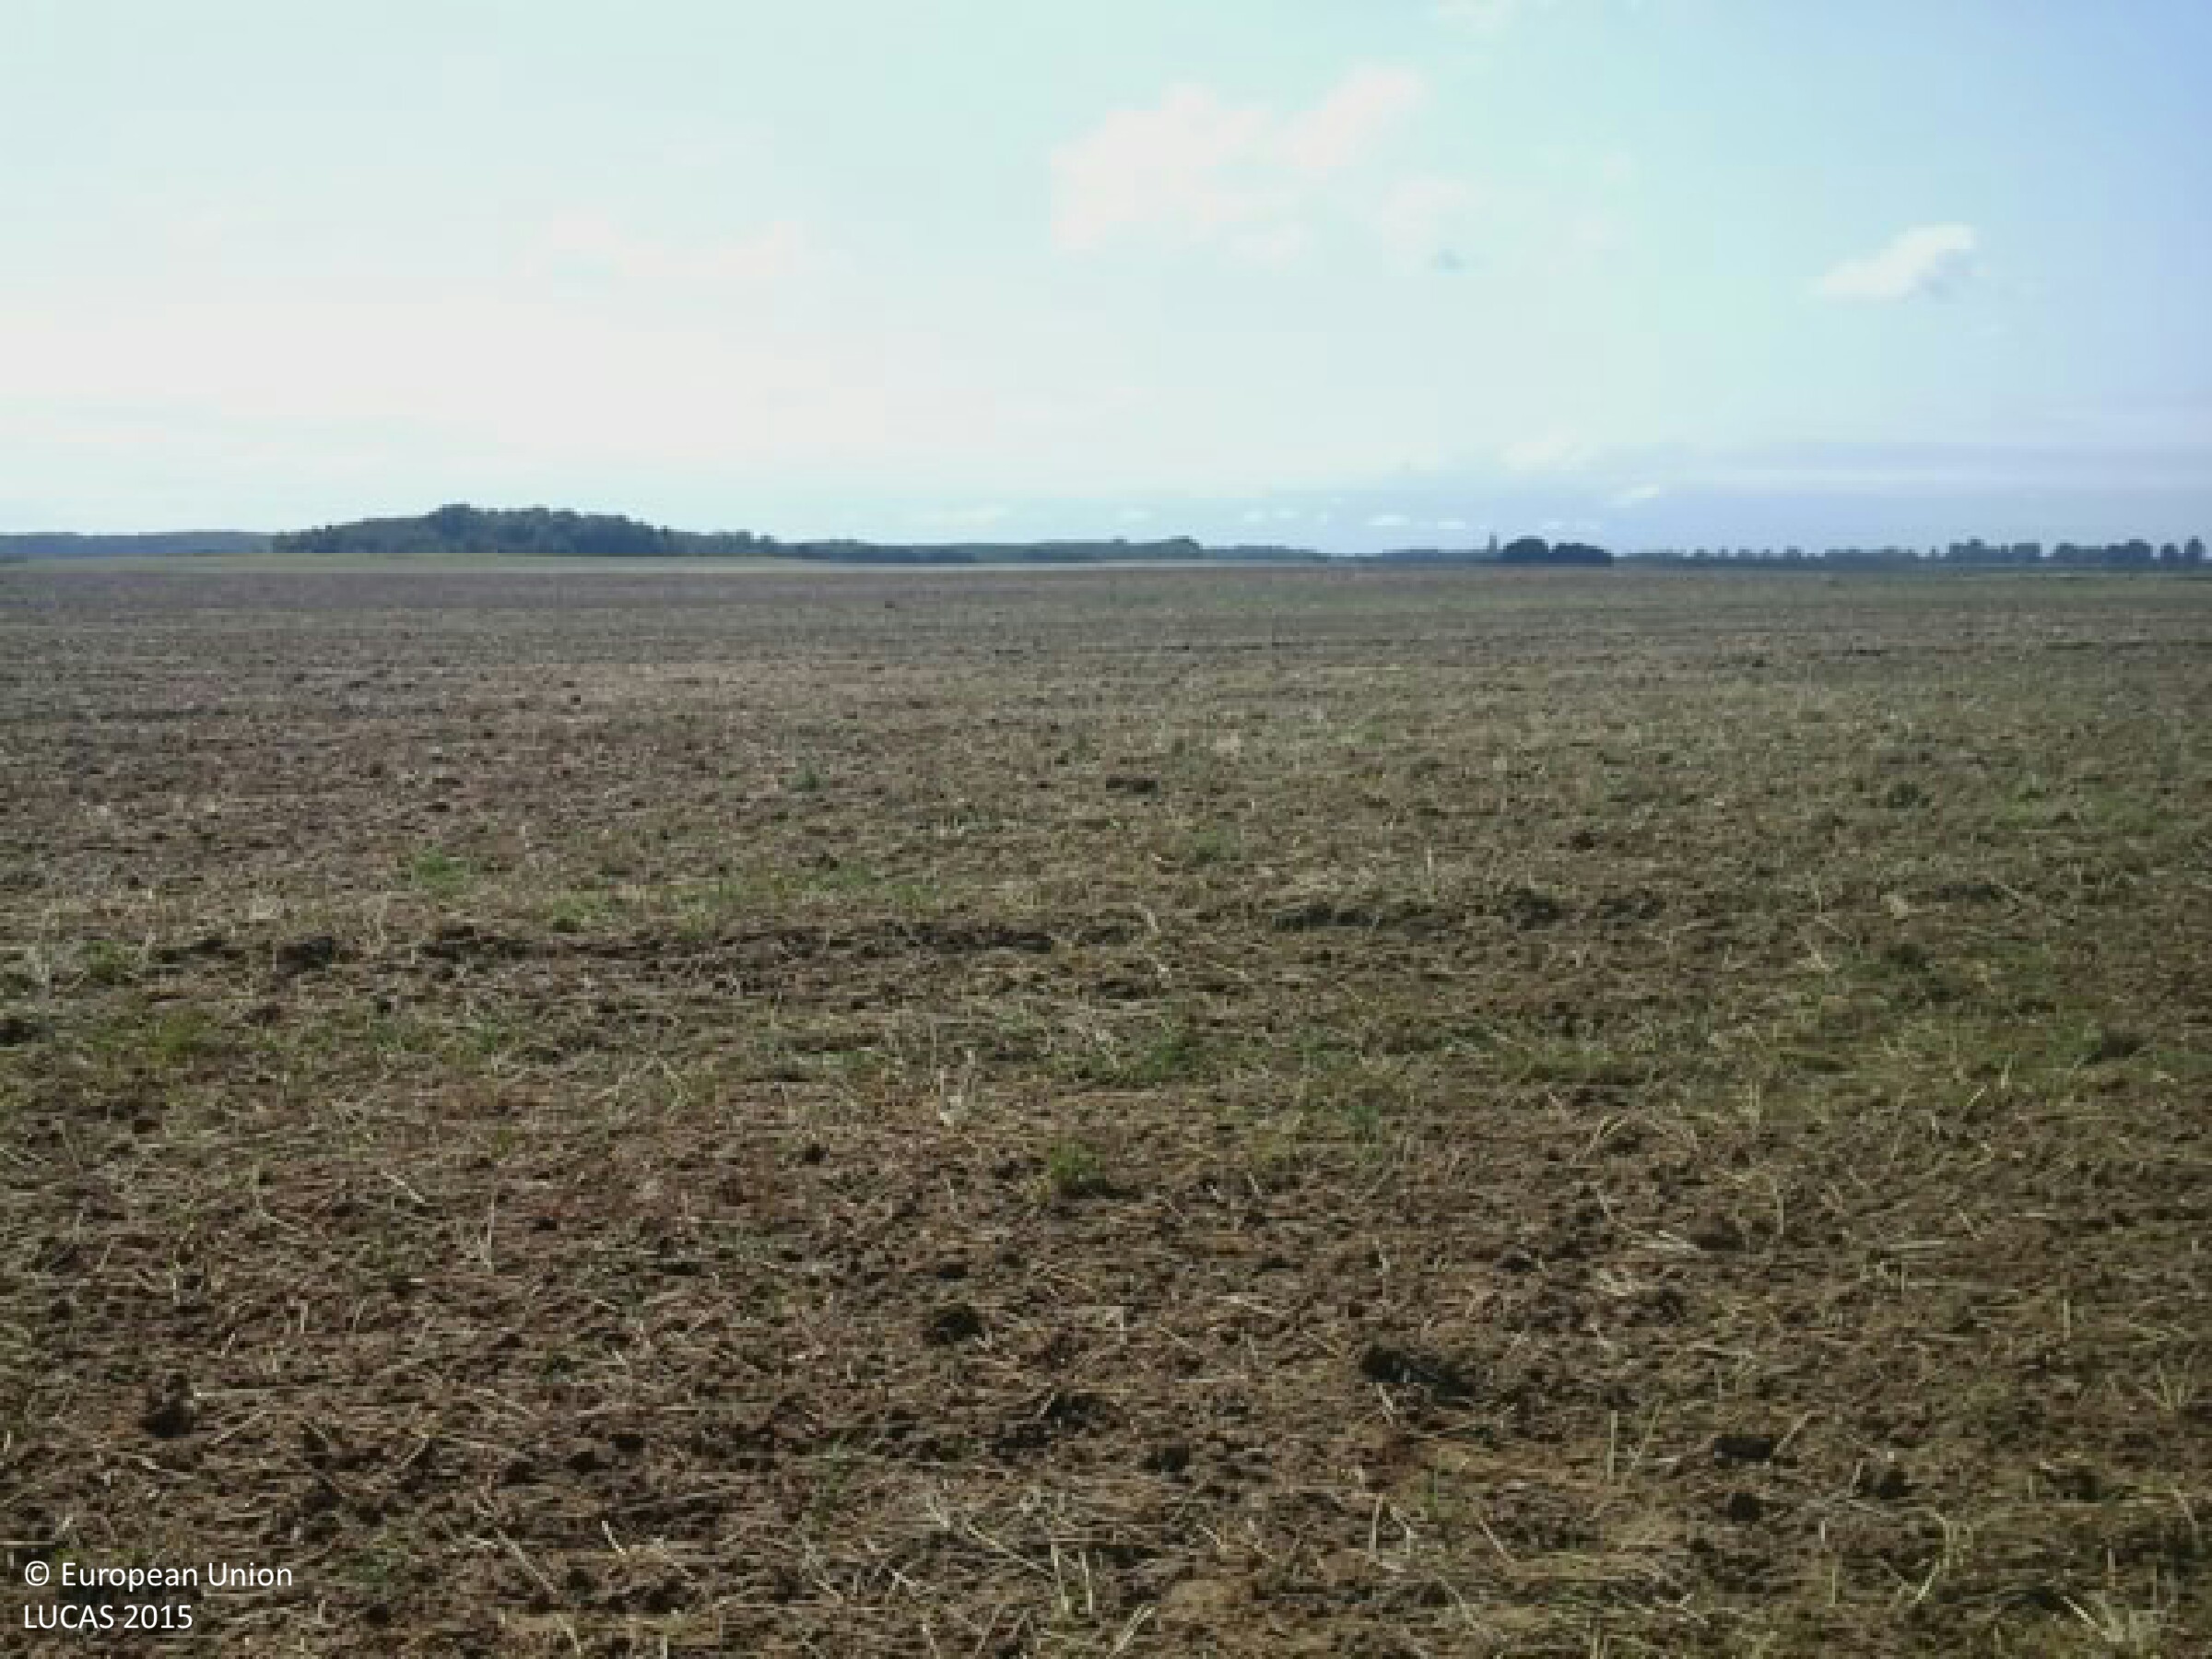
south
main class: Cropland
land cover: Common wheat
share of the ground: < 10 %
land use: Agriculture (excluding fallow land and kitchen gardens)
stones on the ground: < 10 %
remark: Harvested field
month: August
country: HU
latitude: 46.1866
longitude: 17.6356
